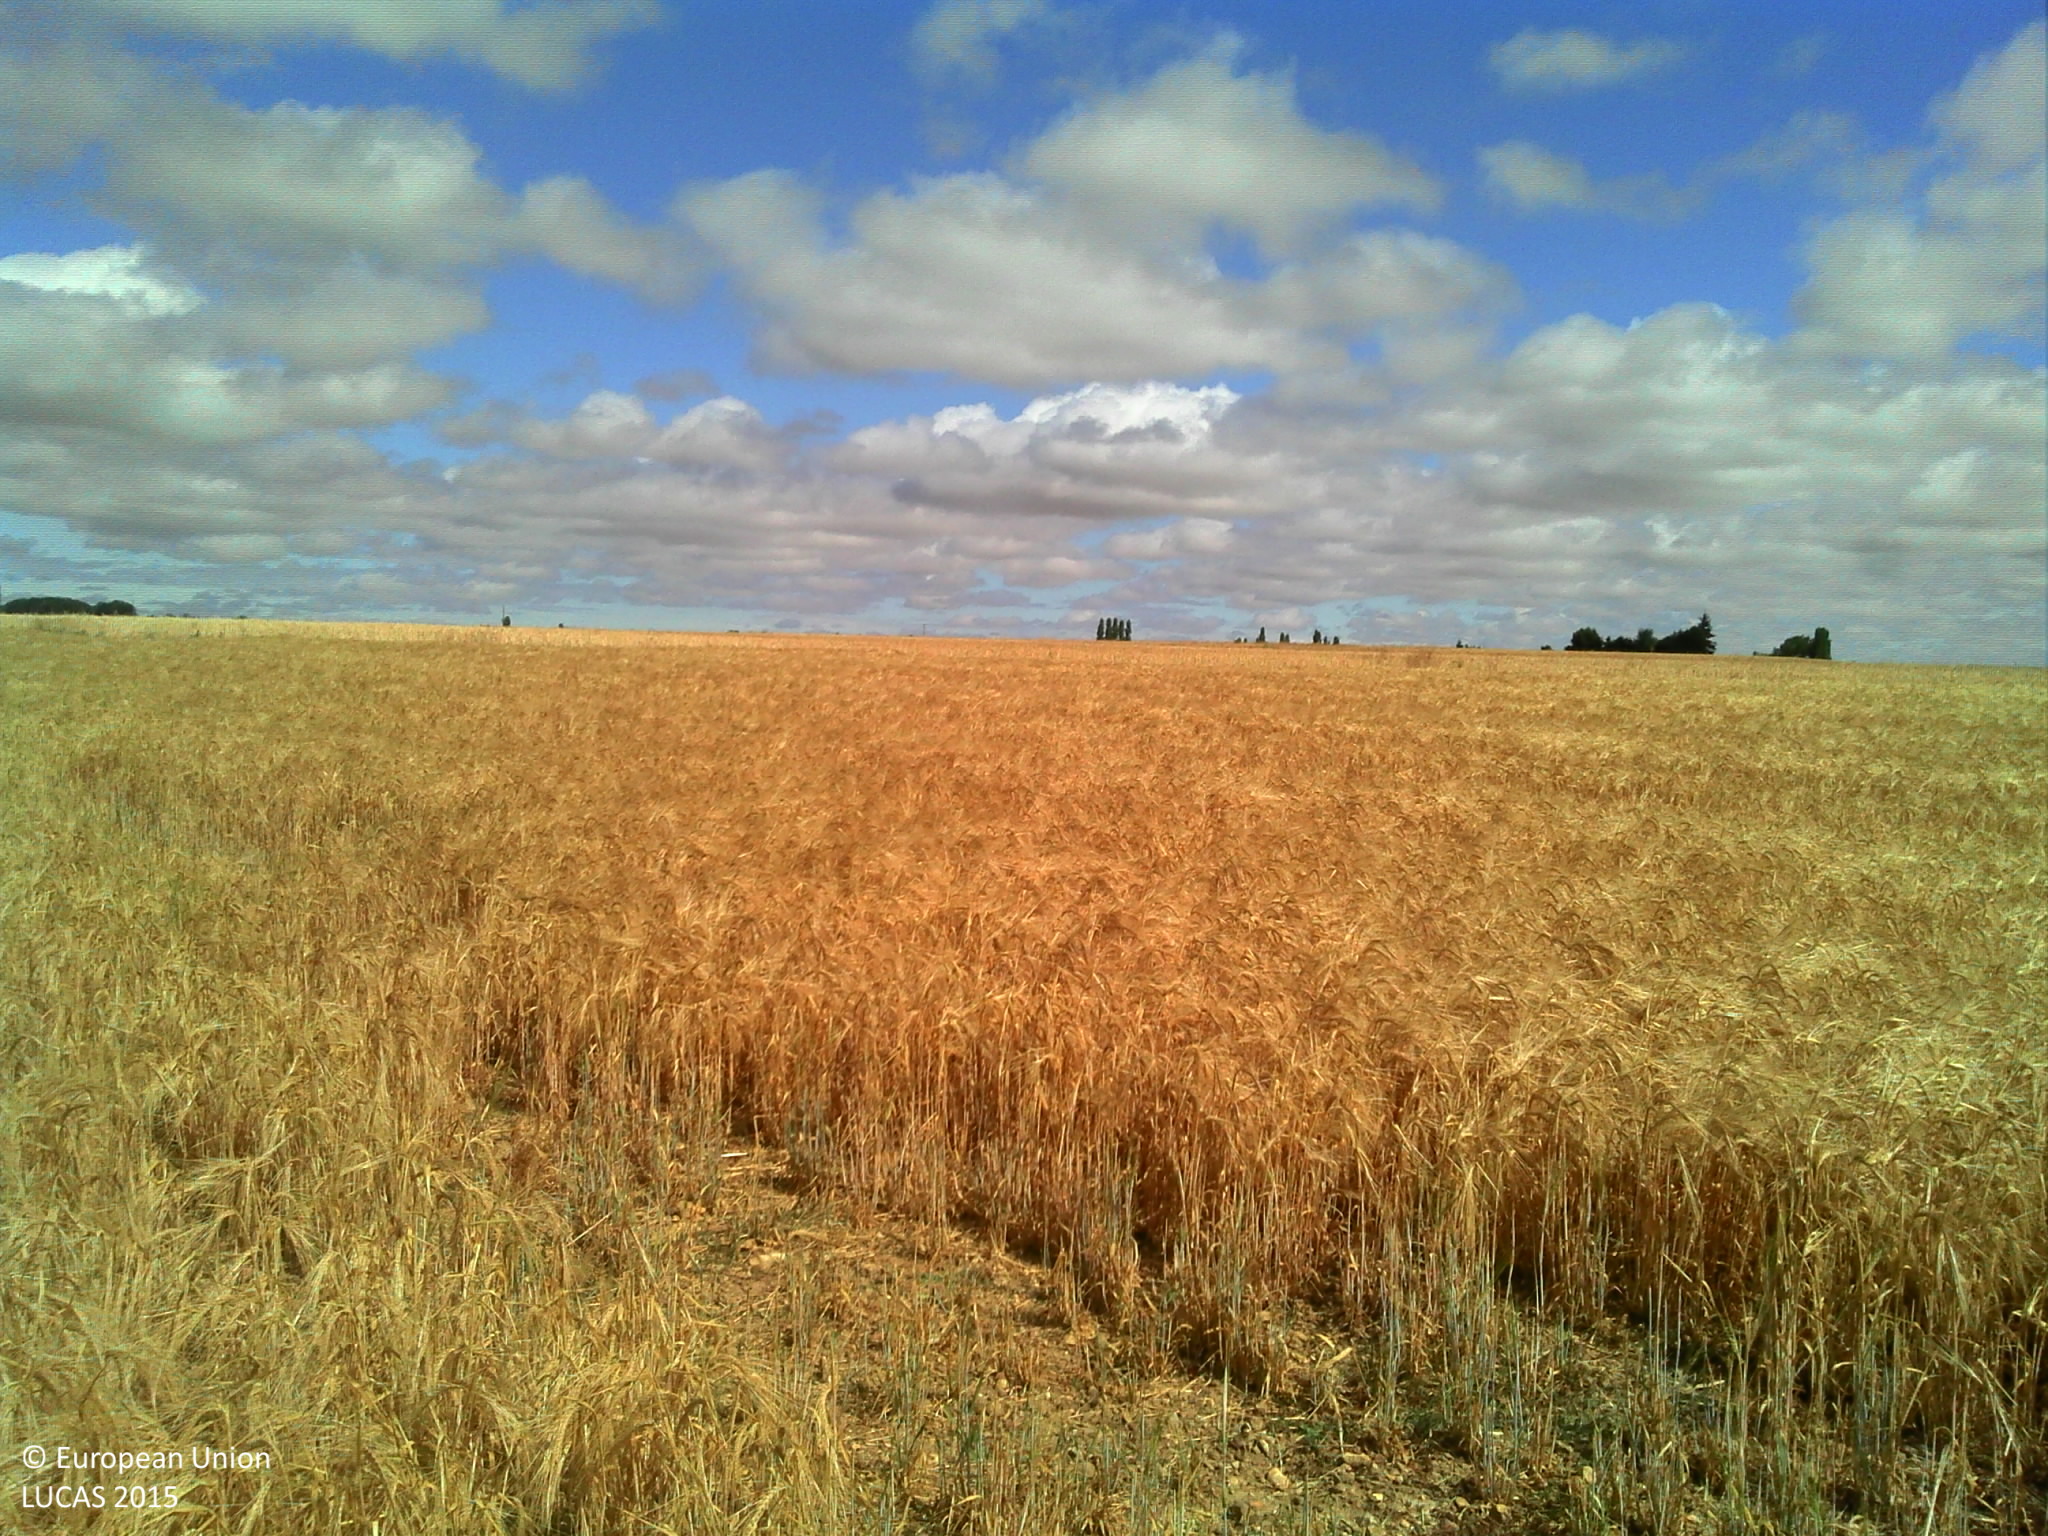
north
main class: Cropland
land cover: Barley
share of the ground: > 75 %
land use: Agriculture (excluding fallow land and kitchen gardens)
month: July
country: FR
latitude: 48.2744
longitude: 1.2643
